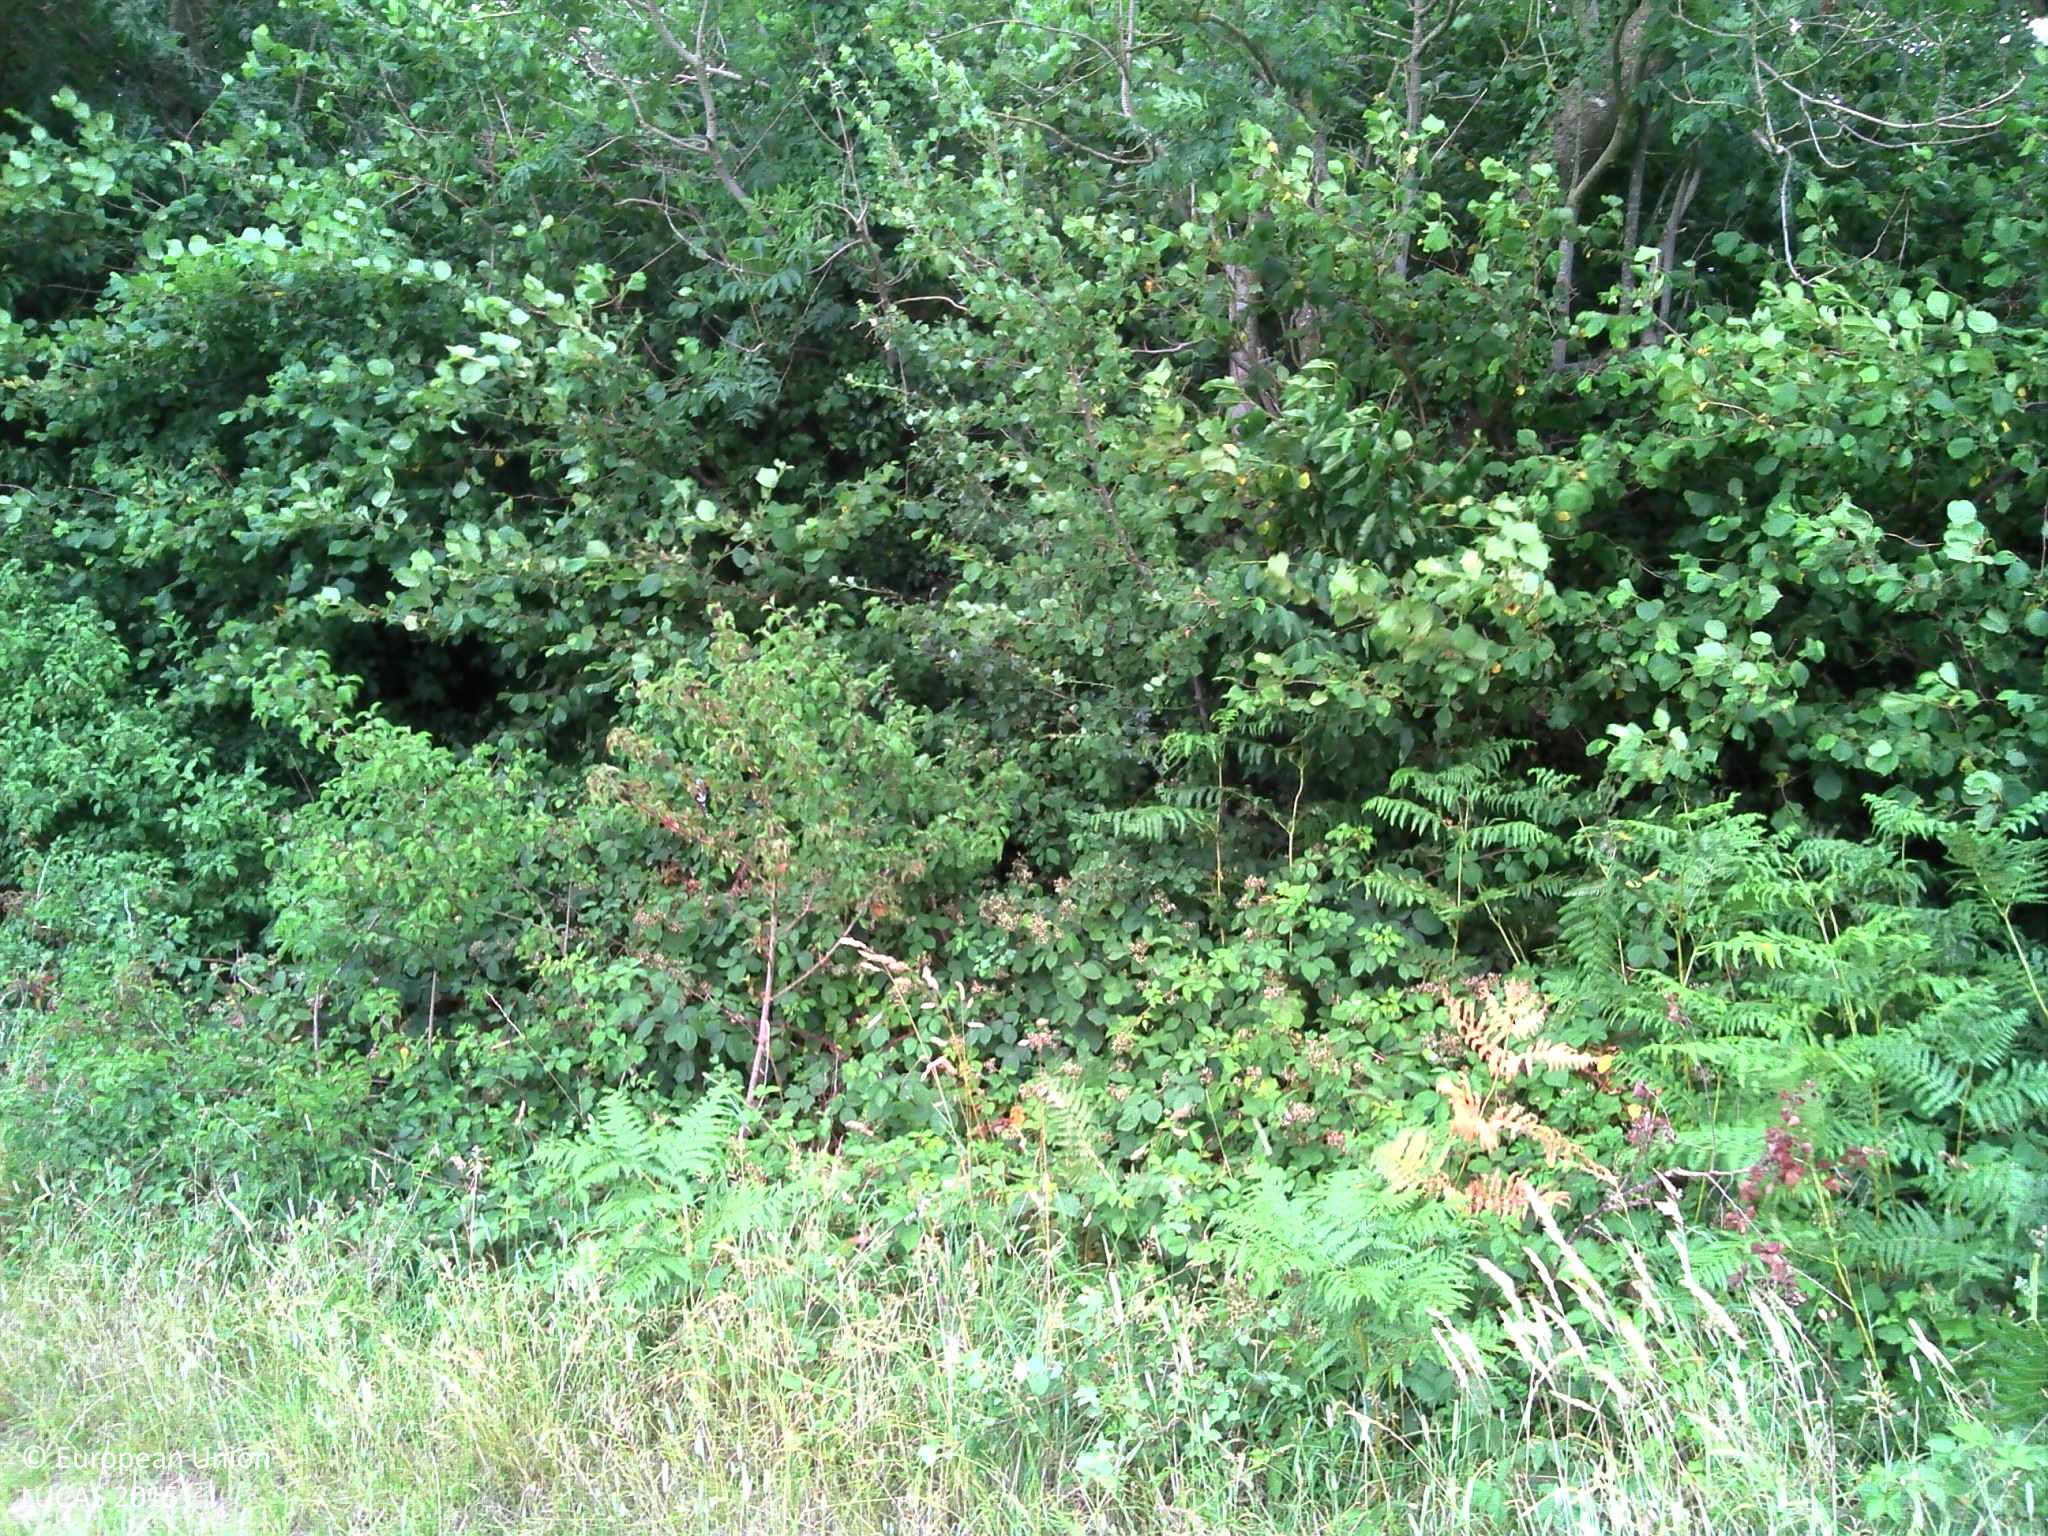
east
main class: Woodland
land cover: Broadleaved woodland
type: mesophytic deciduous forest
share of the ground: > 75 %
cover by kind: broadleaved forest trees 85 %, shrubs 10 %, herbaceous plants 5 %
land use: Forestry
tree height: > 5 m
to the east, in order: Broadleaved woodland; Tracks; Broadleaved woodland
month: July
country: FR
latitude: 49.5165
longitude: 1.9040
